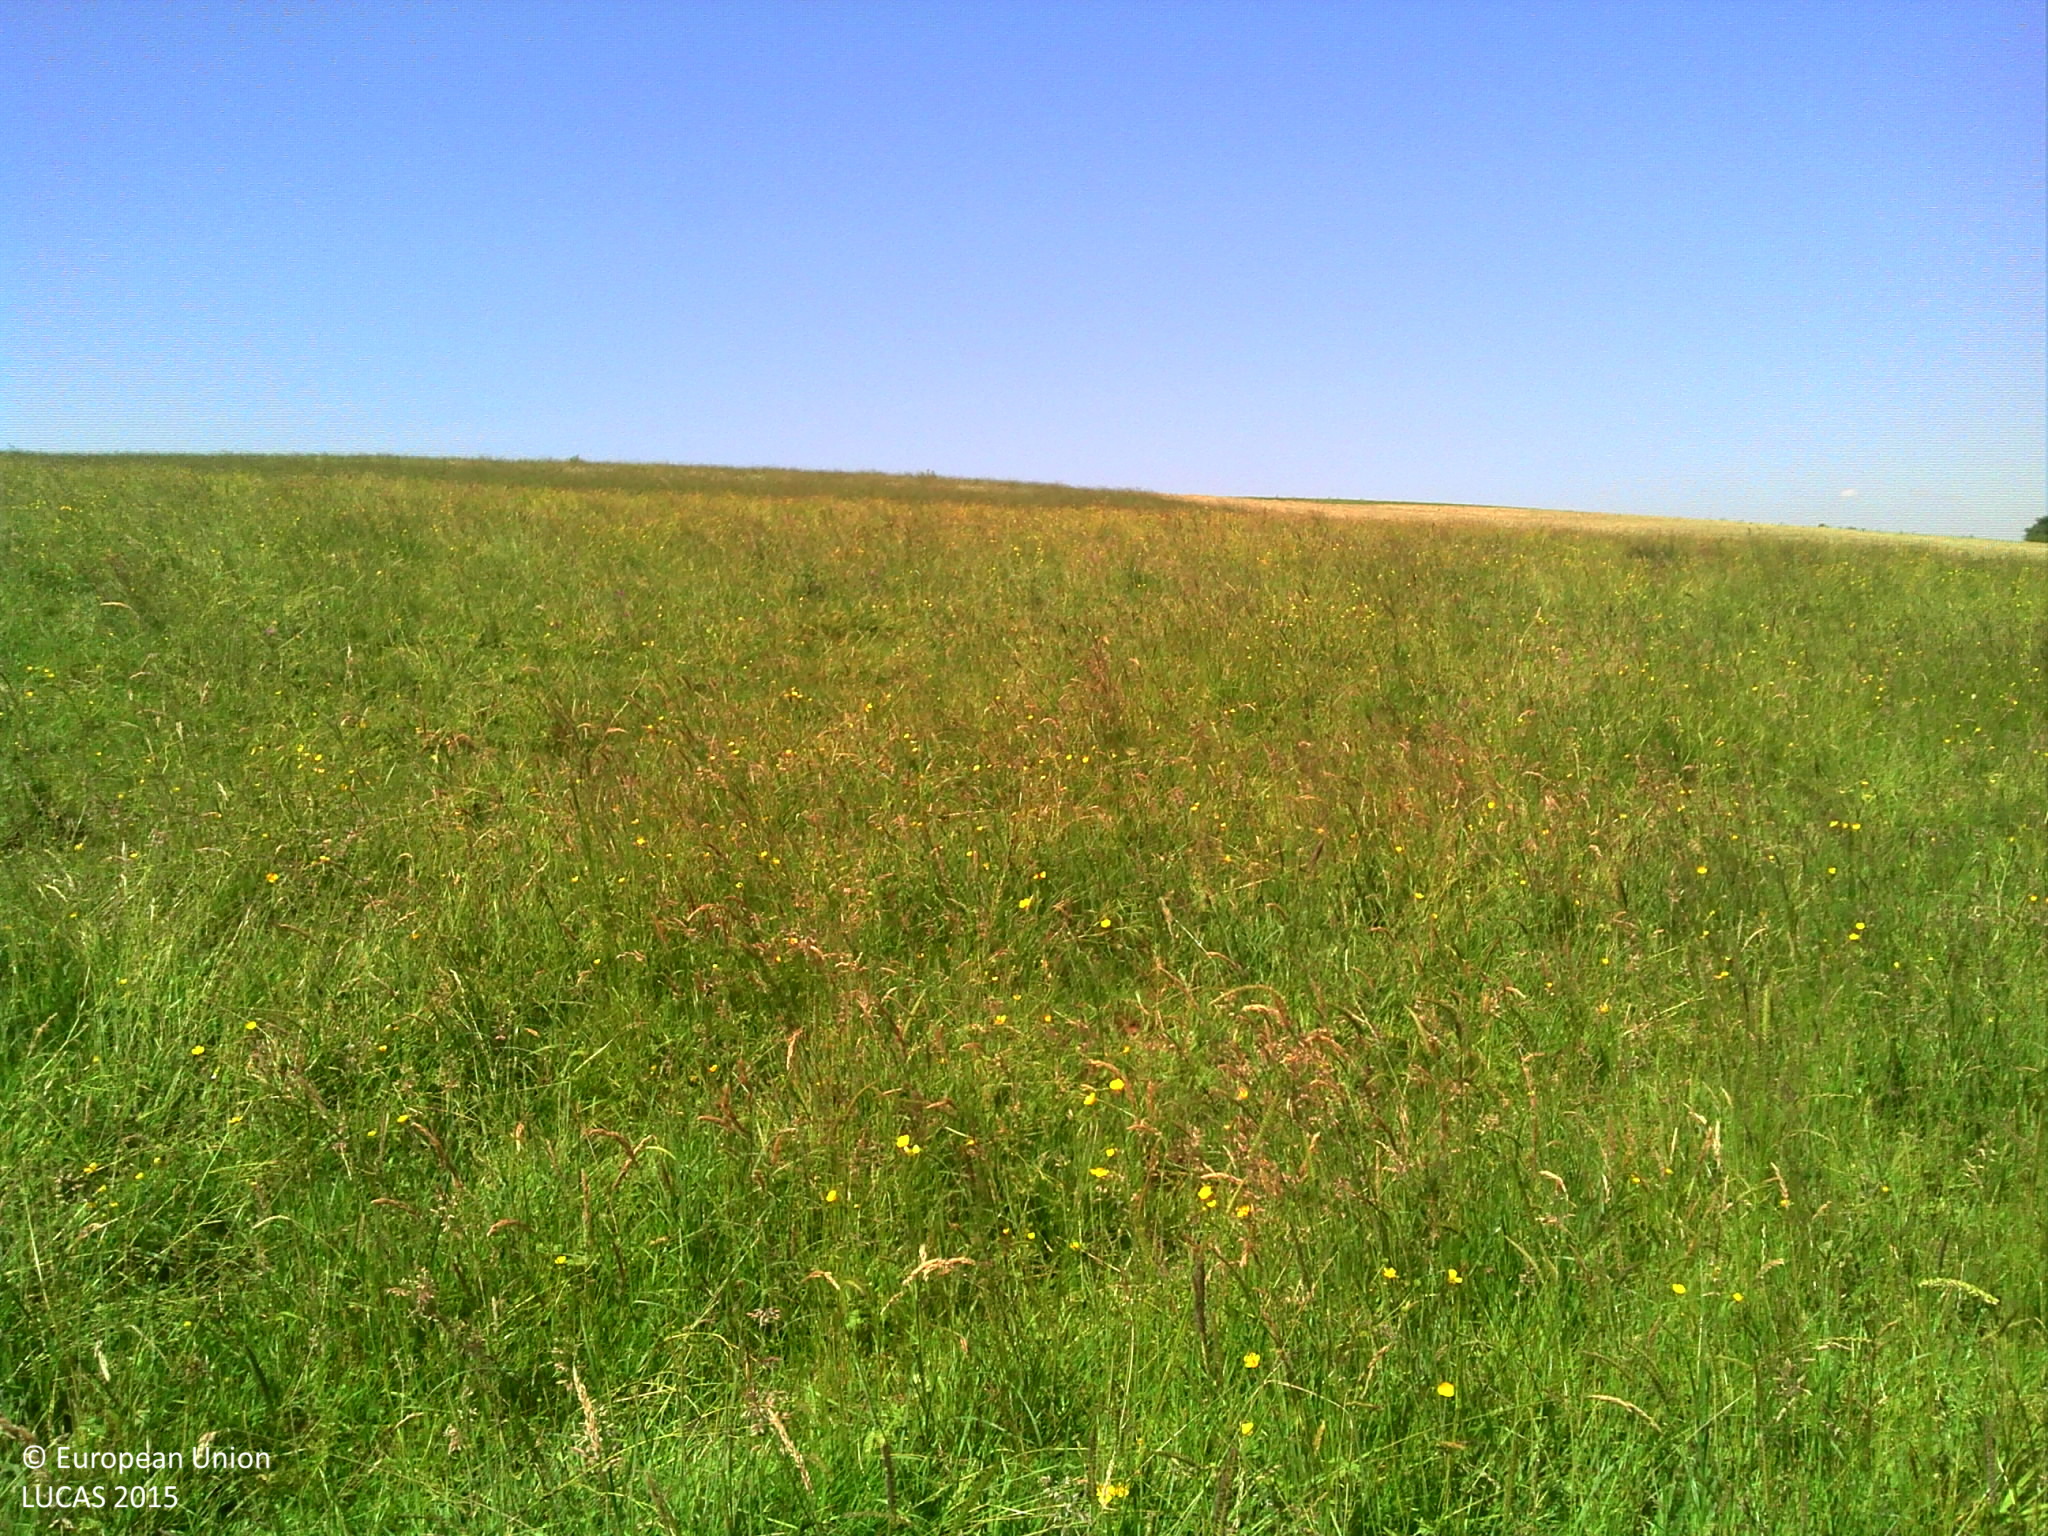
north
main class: Grassland
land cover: Grassland without tree/shrub cover
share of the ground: > 75 %
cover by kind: herbaceous plants 100 %
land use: Agriculture (excluding fallow land and kitchen gardens)
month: June
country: FR
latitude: 47.6907
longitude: 6.2307
